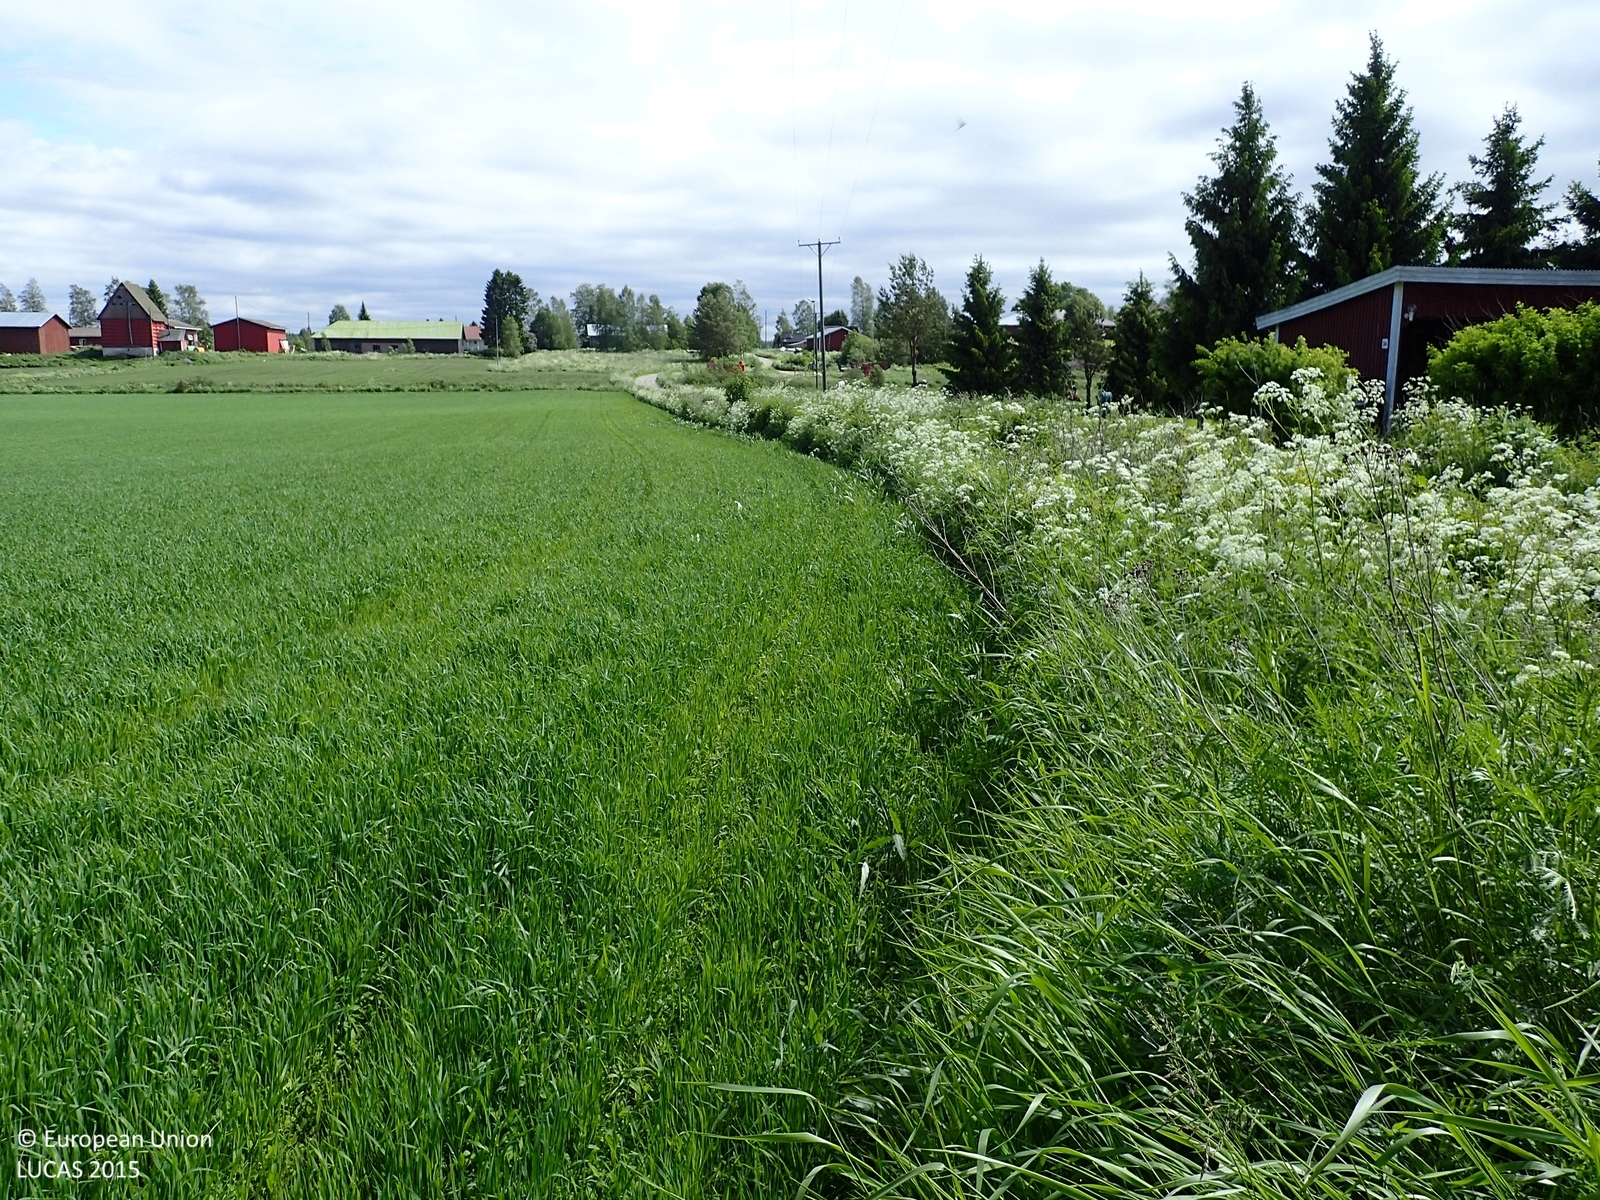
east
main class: Cropland
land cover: Oats
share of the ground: > 75 %
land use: Agriculture (excluding fallow land and kitchen gardens)
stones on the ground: < 10 %
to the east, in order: Oats; Shruby margins; Ditches and canals; Shruby margins; Oats; Electric lines; Oats
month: June
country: FI
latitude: 62.3854
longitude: 21.5511
